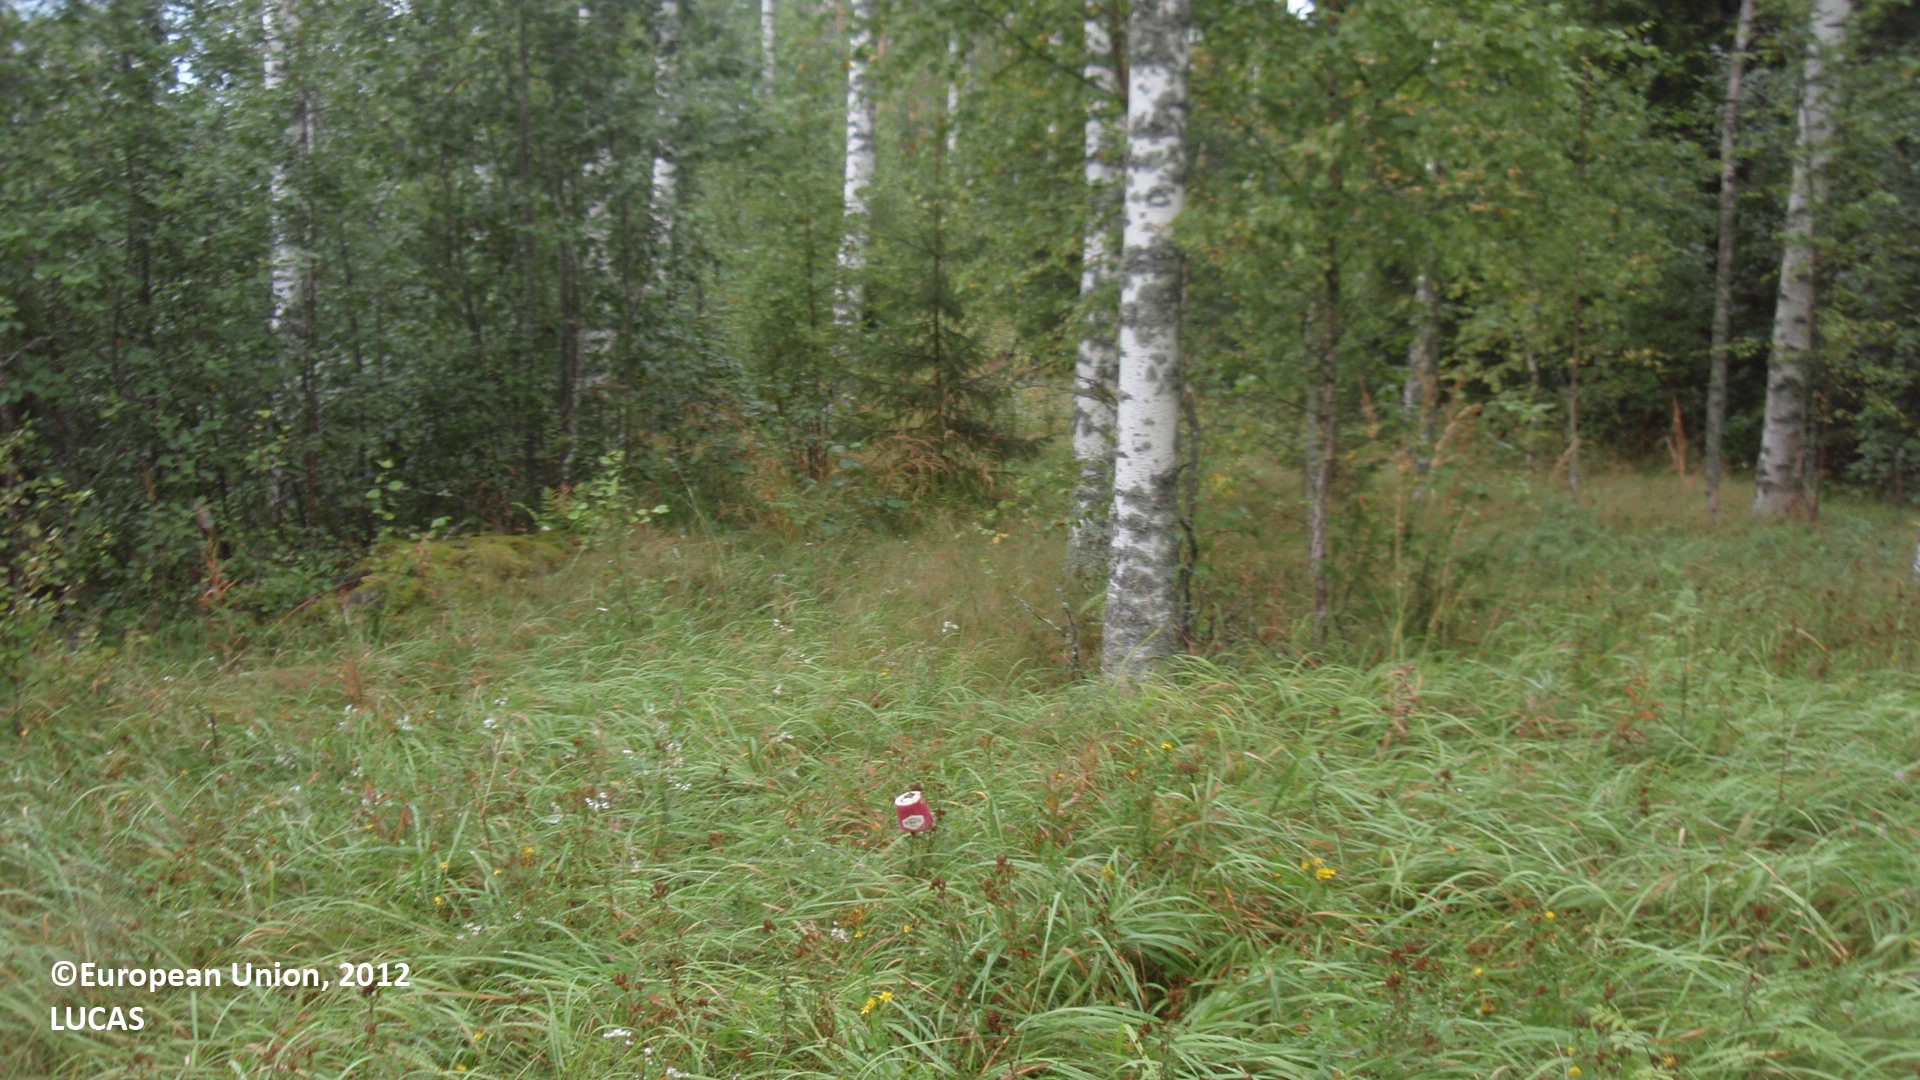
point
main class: Woodland
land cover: Broadleaved woodland
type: non-riverine alder, birch or aspen forest
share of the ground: 50 - 75 %
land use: Forestry
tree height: > 5 m
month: August
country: FI
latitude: 61.3242
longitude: 26.9570
